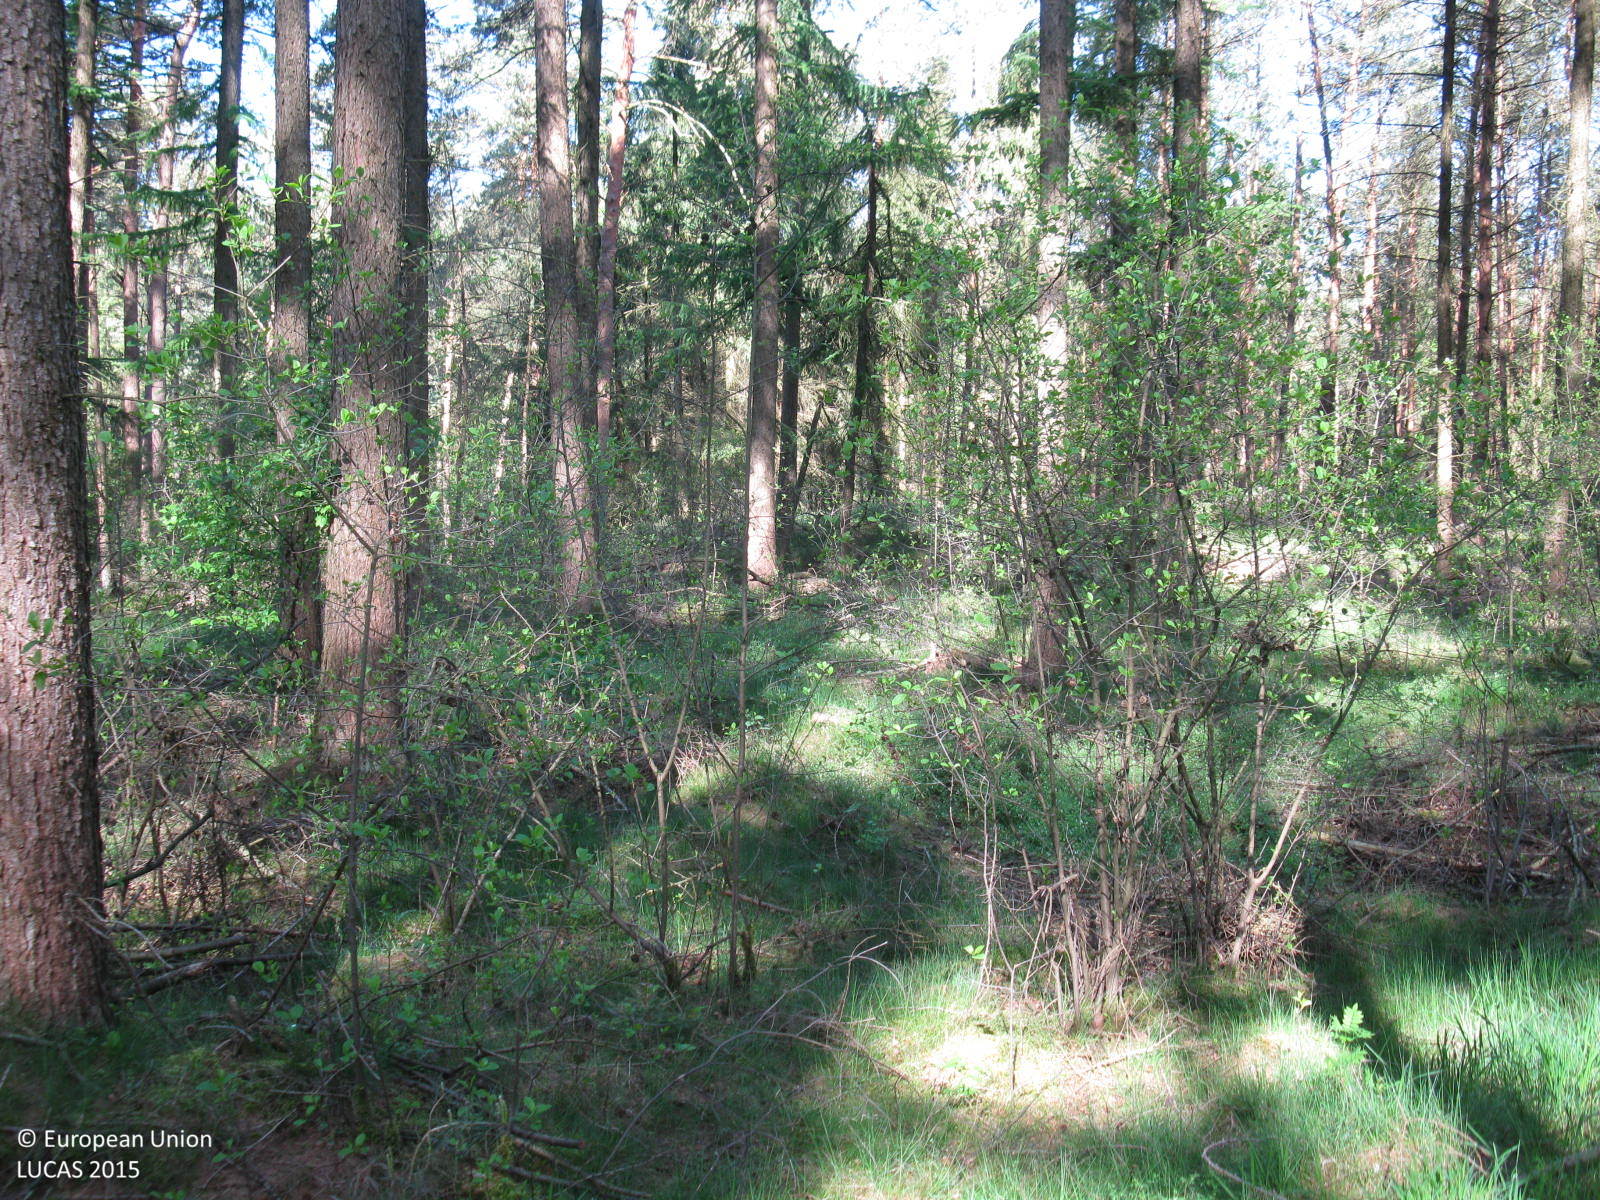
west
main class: Woodland
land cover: Other coniferous woodland
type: hemiboreal forest and nemoral coniferous forest and mixed broadleaved-coniferous forest
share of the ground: > 75 %
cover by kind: coniferous forest trees 100 %
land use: Forestry
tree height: > 5 m
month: May
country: DE
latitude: 52.8147
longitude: 7.3149
